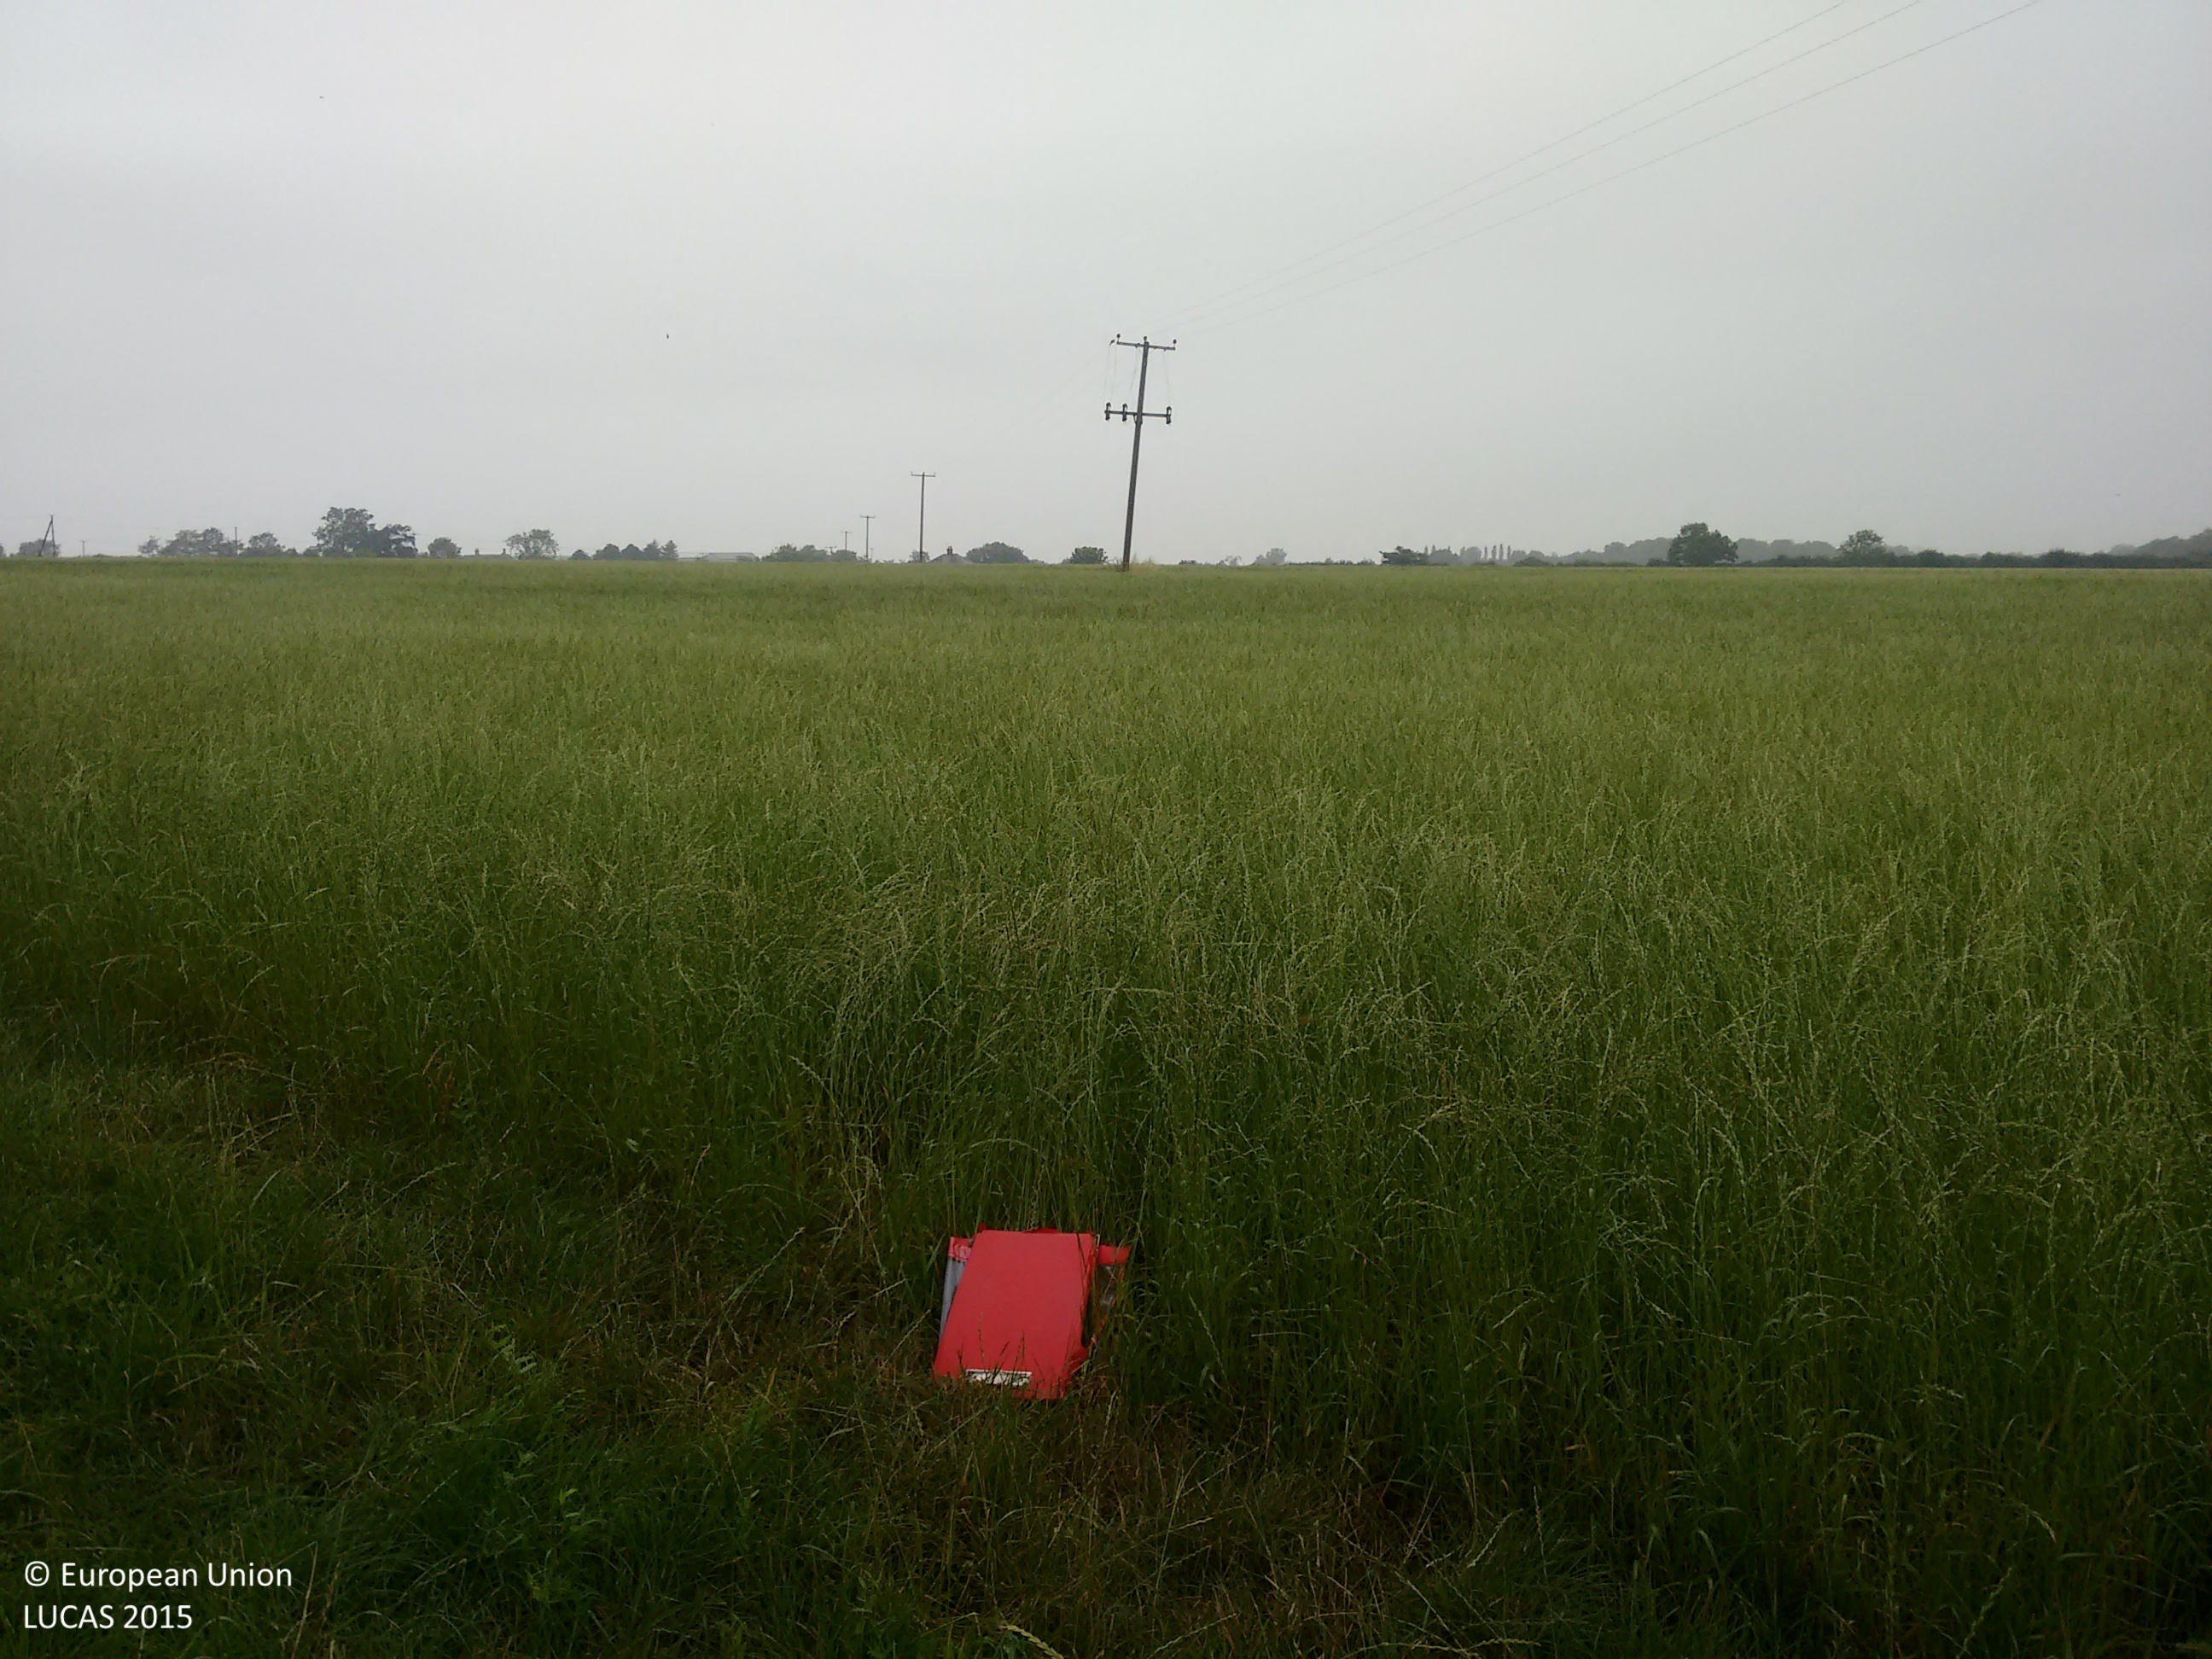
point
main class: Cropland
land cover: Temporary grasslands
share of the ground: > 75 %
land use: Agriculture (excluding fallow land and kitchen gardens)
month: July
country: GB
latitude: 51.7495
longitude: 0.3674
